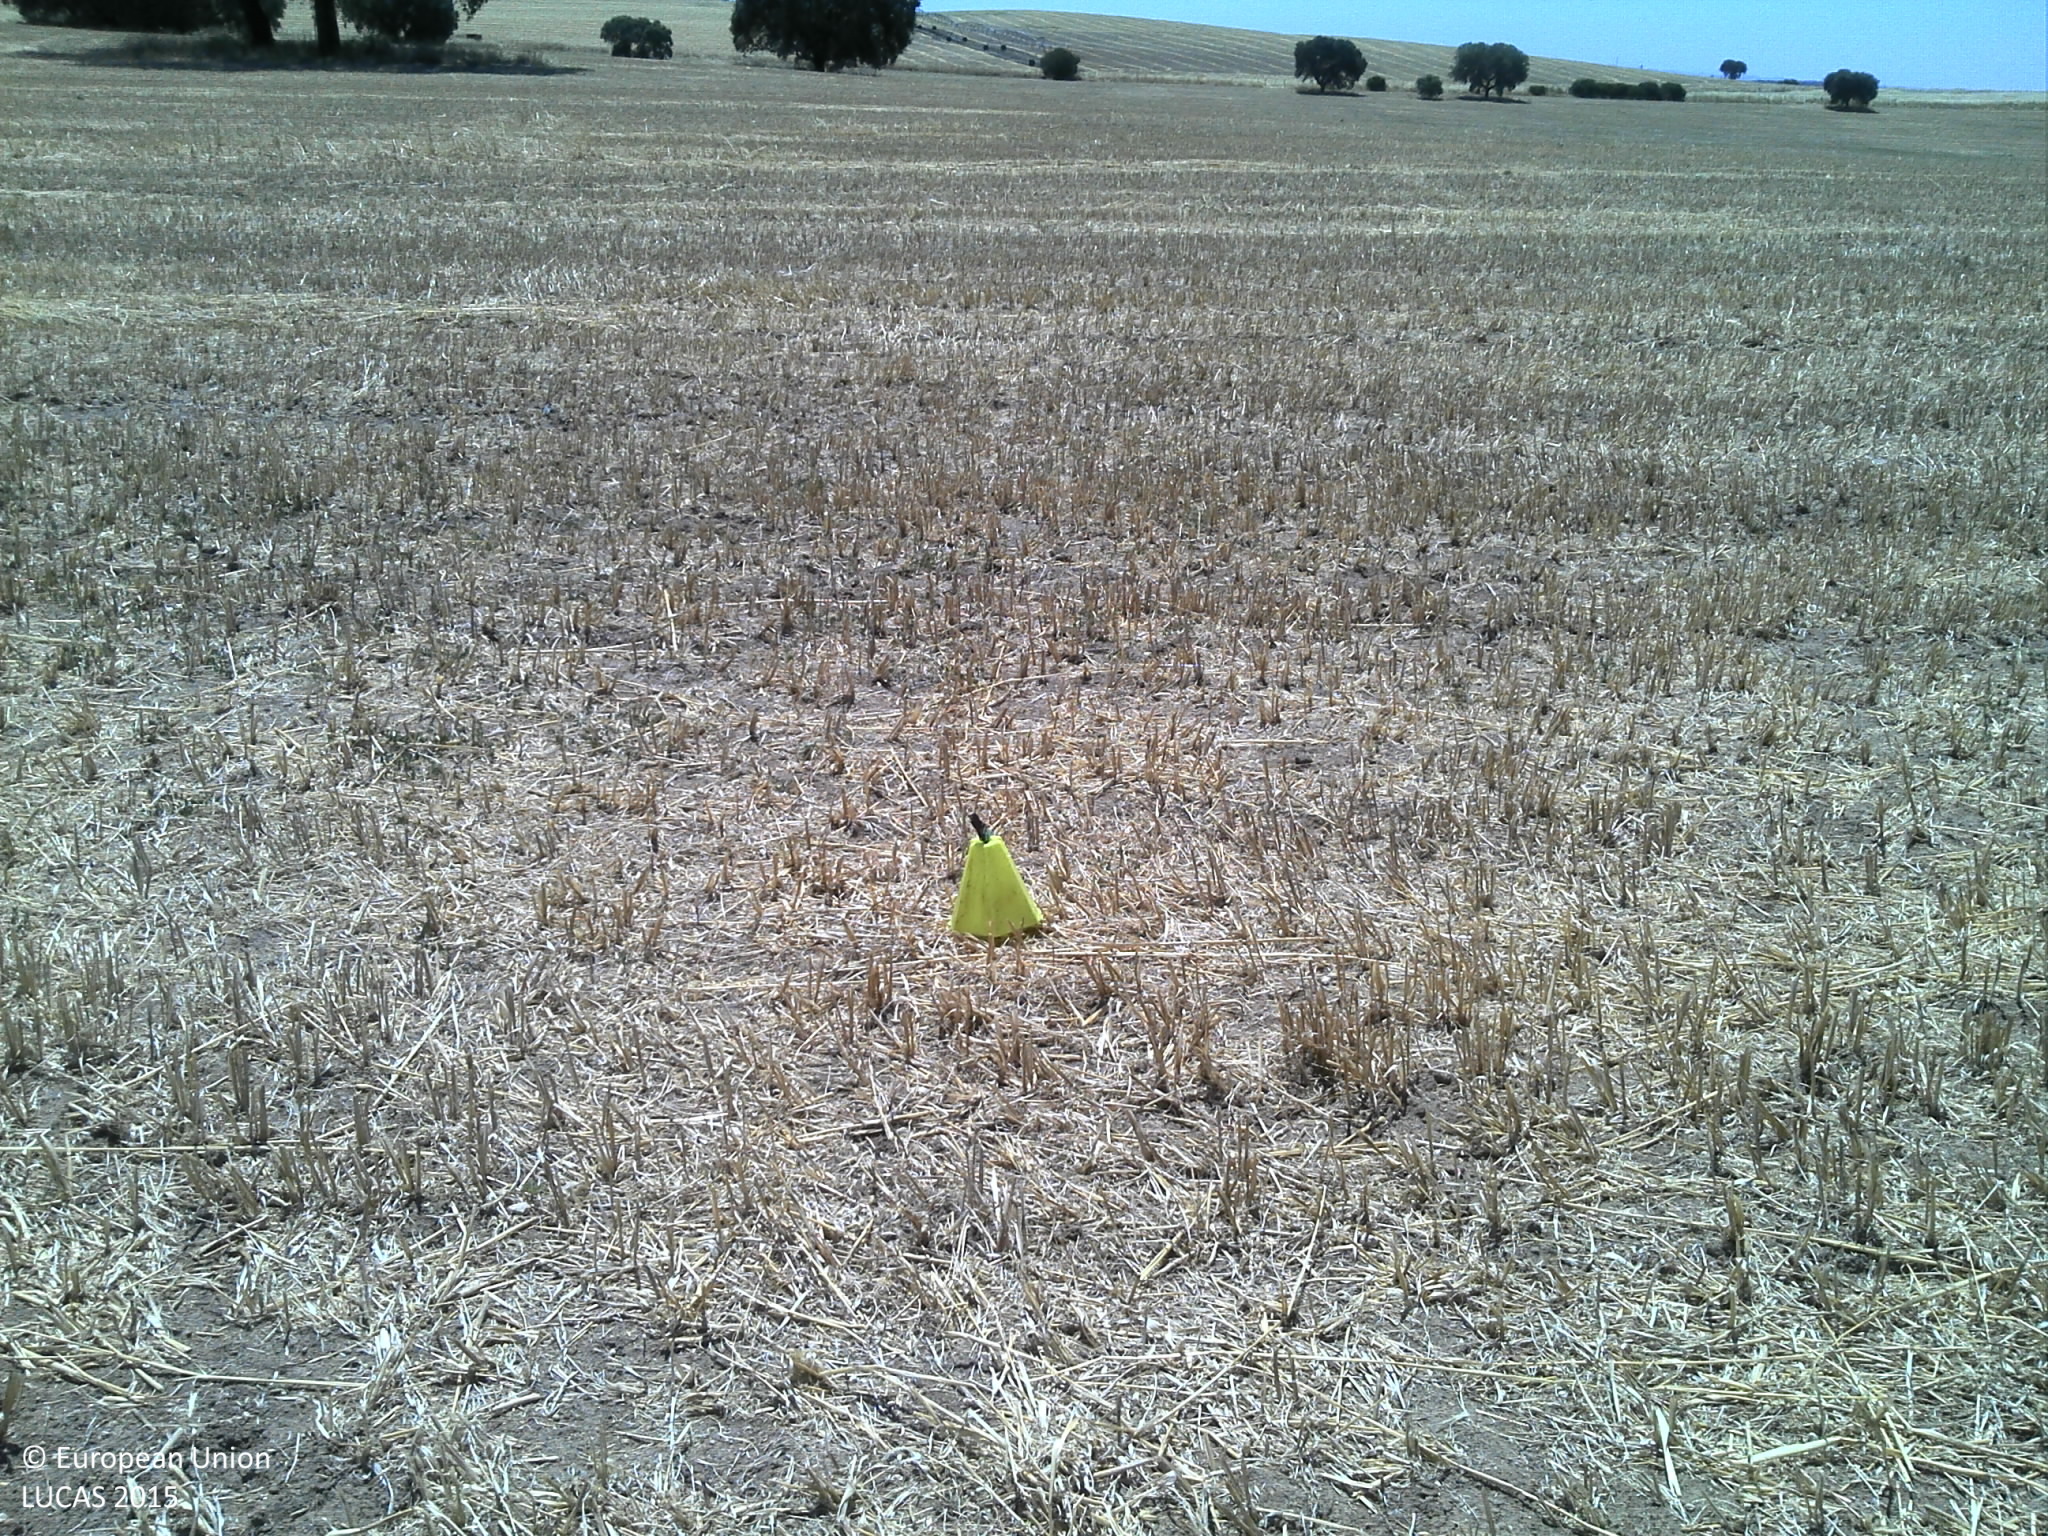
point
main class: Cropland
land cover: Oats
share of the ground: < 10 %
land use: Agriculture (excluding fallow land and kitchen gardens)
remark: Harvested field
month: July
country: PT
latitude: 38.9734
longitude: -7.0050
